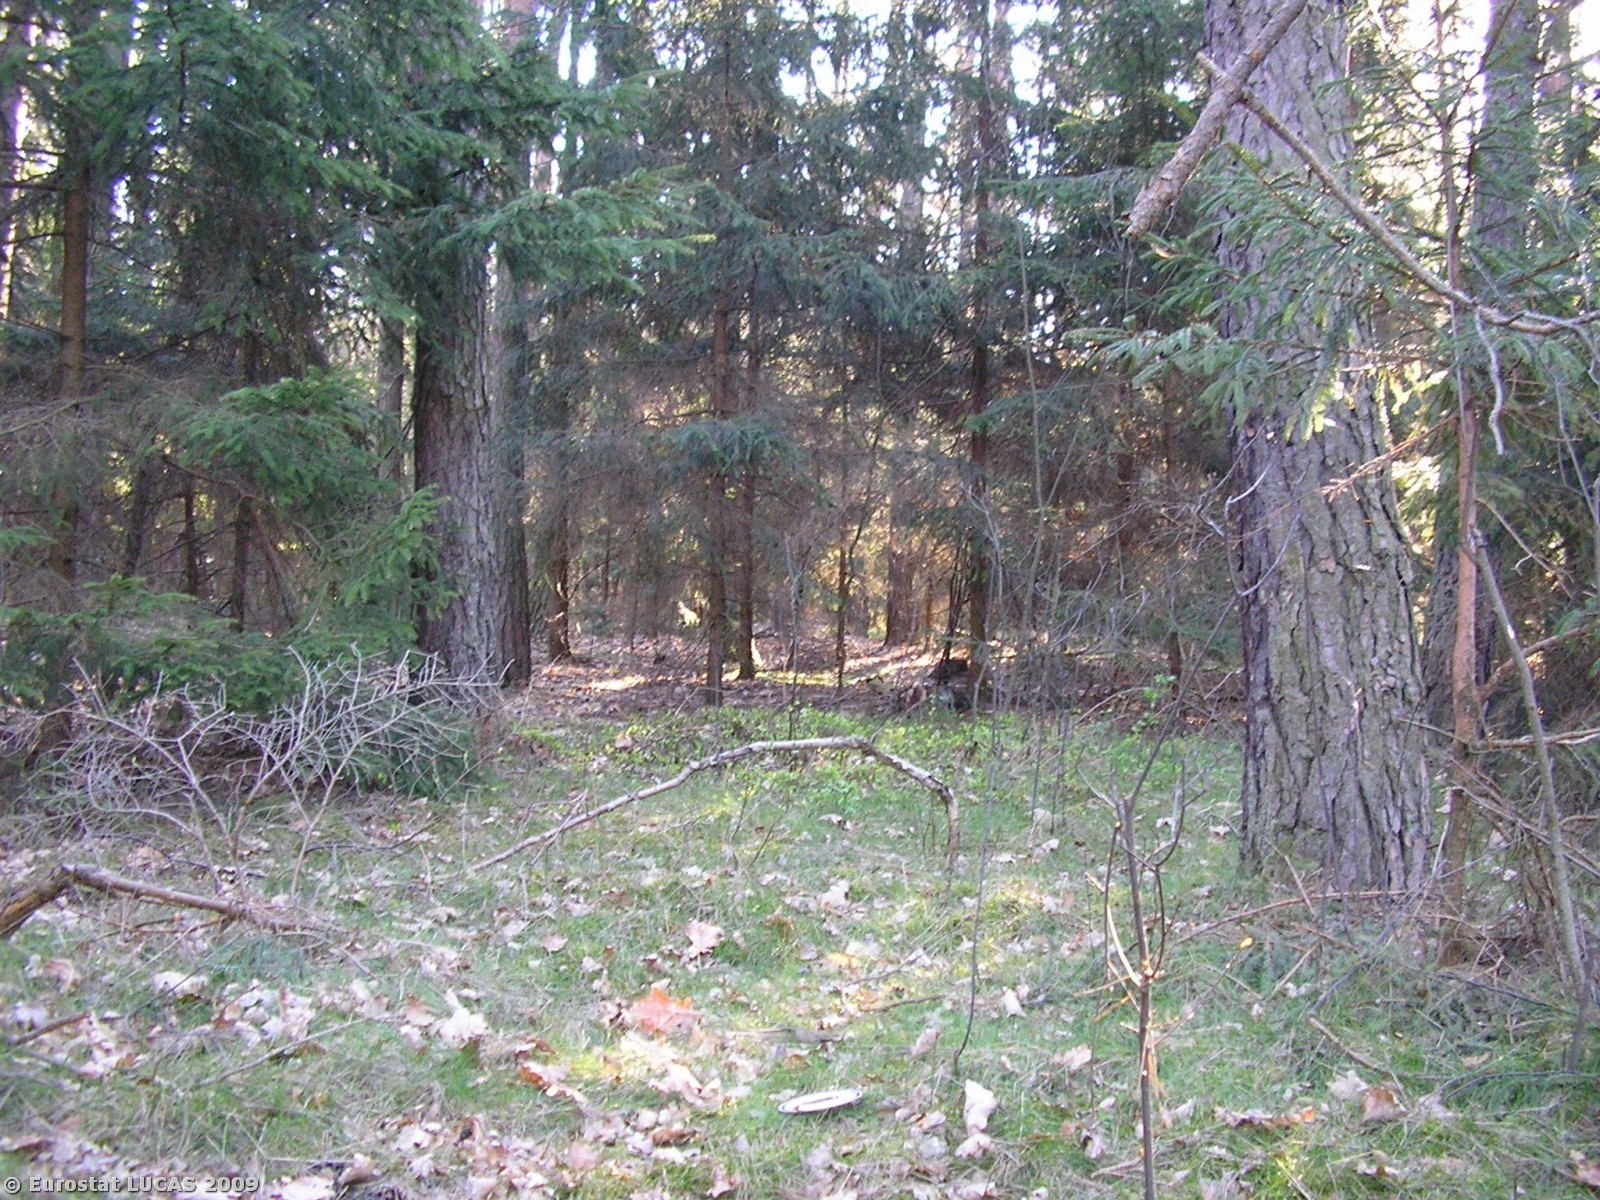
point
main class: Woodland
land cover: Coniferous woodland
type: hemiboreal forest and nemoral coniferous forest and mixed broadleaved-coniferous forest
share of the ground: > 75 %
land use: Forestry
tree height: > 5 m
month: April
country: PL
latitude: 52.0509
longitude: 20.1398
